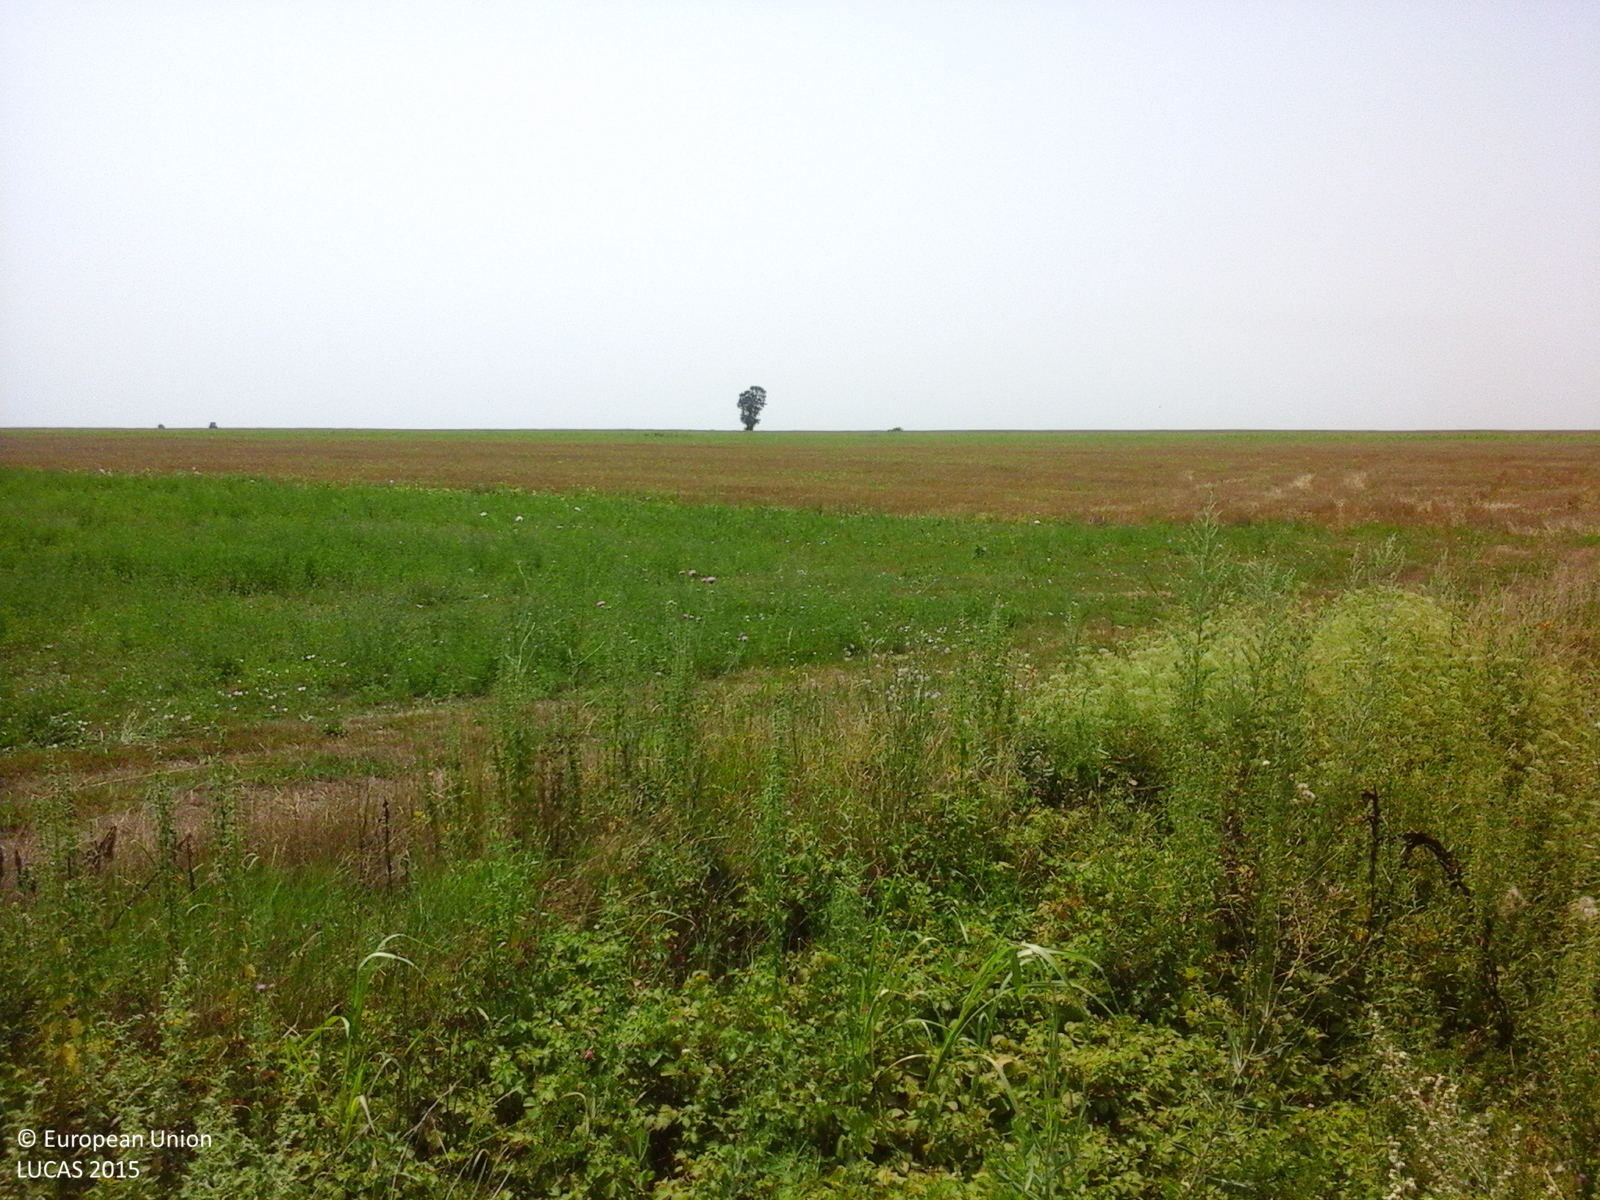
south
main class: Cropland
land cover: Lucerne
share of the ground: 50 - 75 %
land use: Agriculture (excluding fallow land and kitchen gardens)
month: July
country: RO
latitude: 44.6172
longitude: 26.6162
